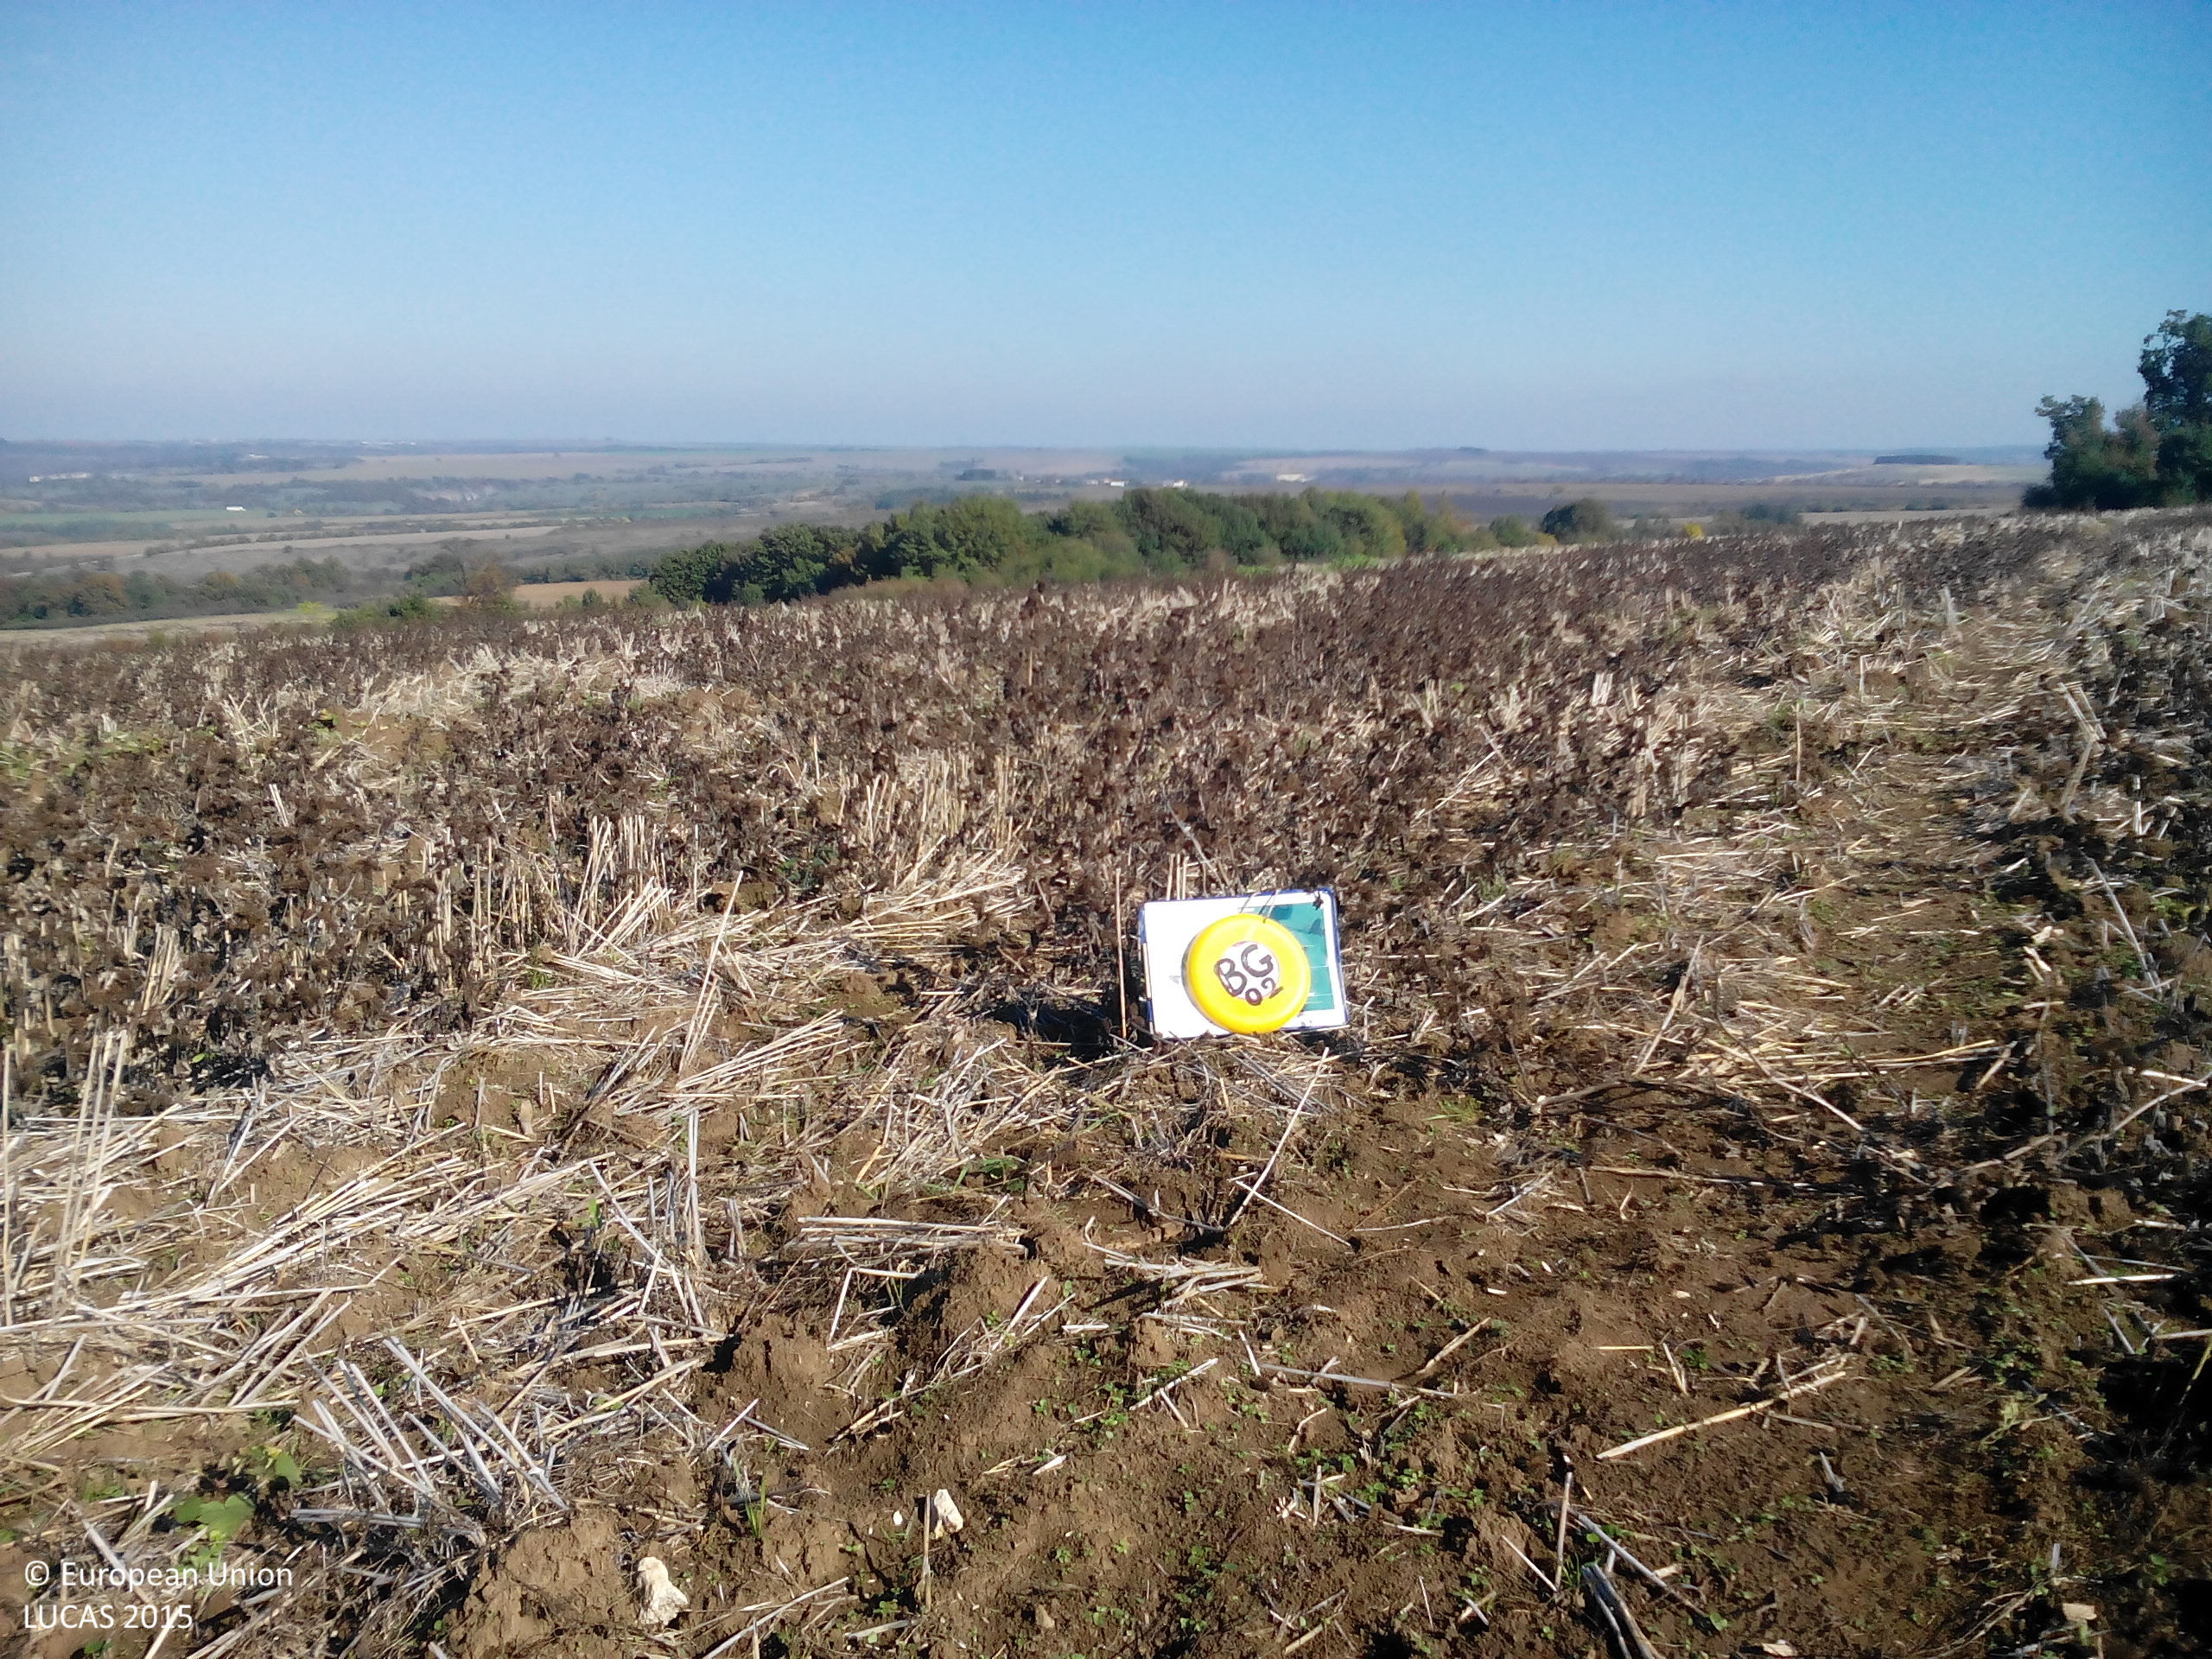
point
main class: Cropland
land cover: Common wheat
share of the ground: < 10 %
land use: Agriculture (excluding fallow land and kitchen gardens)
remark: Harvested field
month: October
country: BG
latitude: 43.2192
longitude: 24.3486
